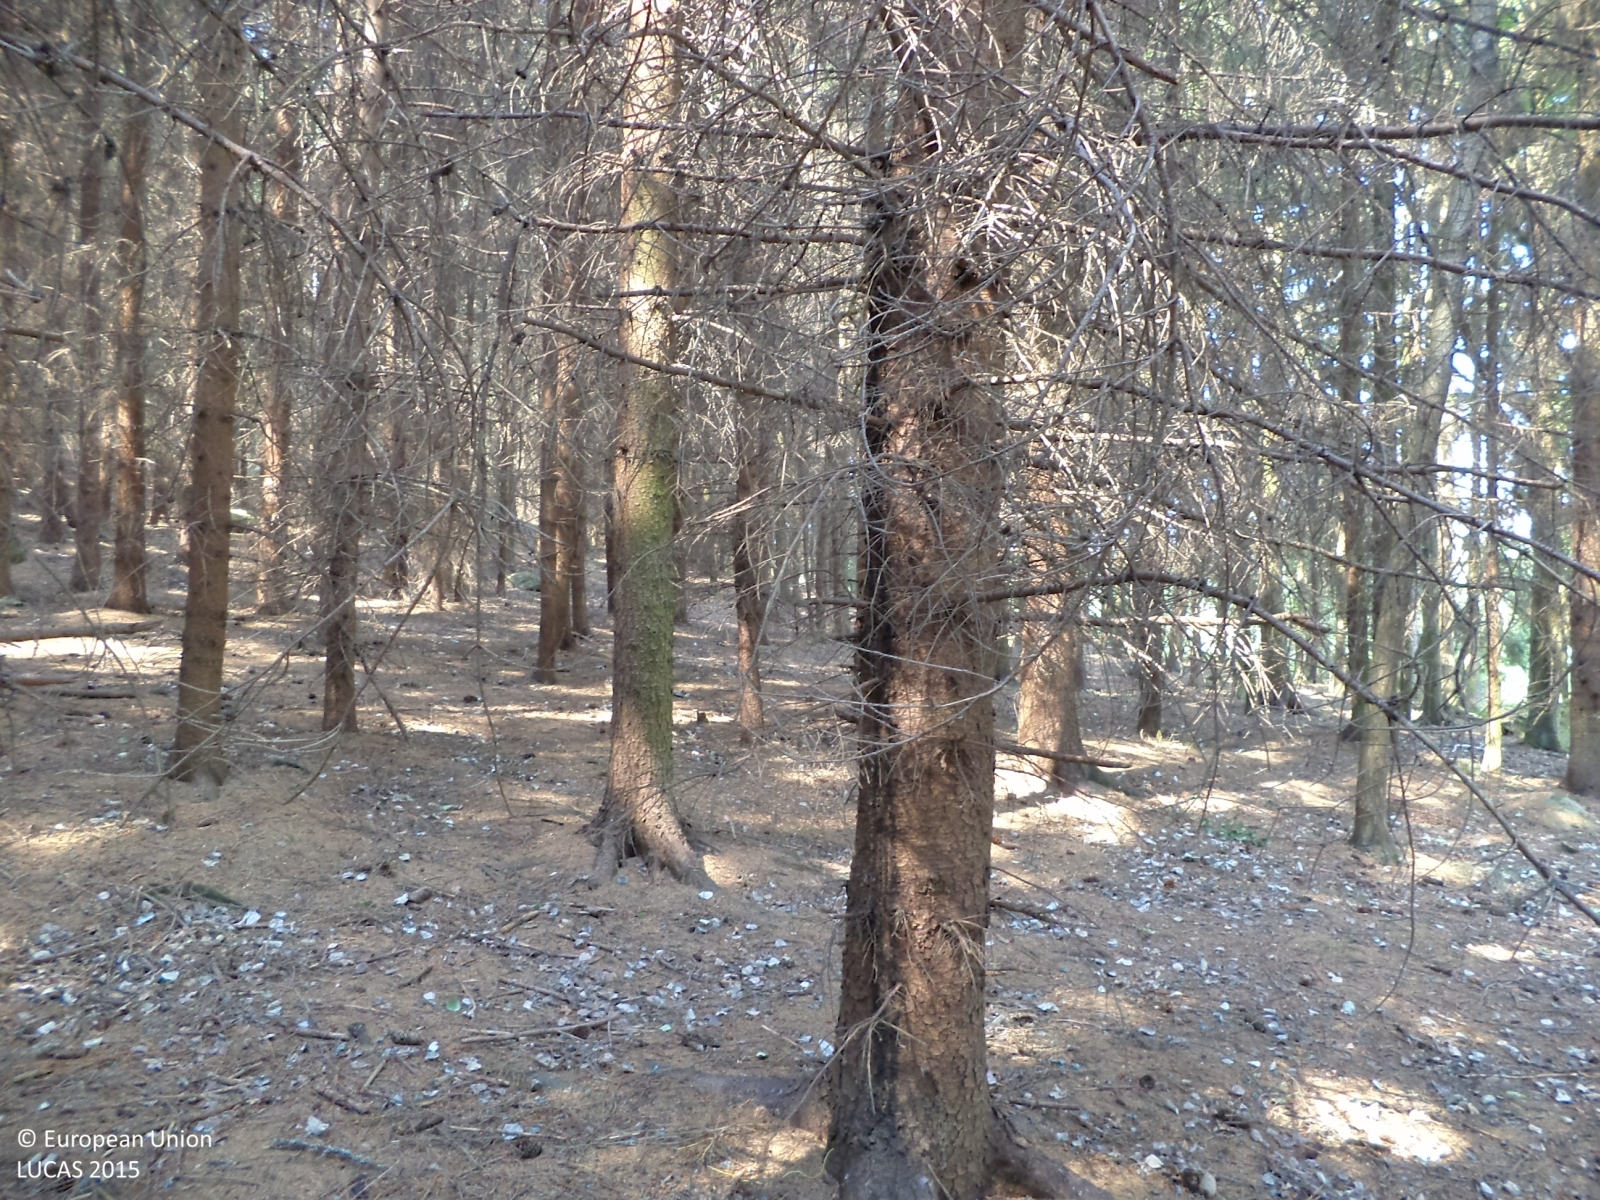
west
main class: Woodland
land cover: Spruce dominated coniferous woodland
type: hemiboreal forest and nemoral coniferous forest and mixed broadleaved-coniferous forest
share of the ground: > 75 %
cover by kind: coniferous forest trees 100 %
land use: Forestry
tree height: > 5 m
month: August
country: CZ
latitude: 49.4340
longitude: 14.3725
